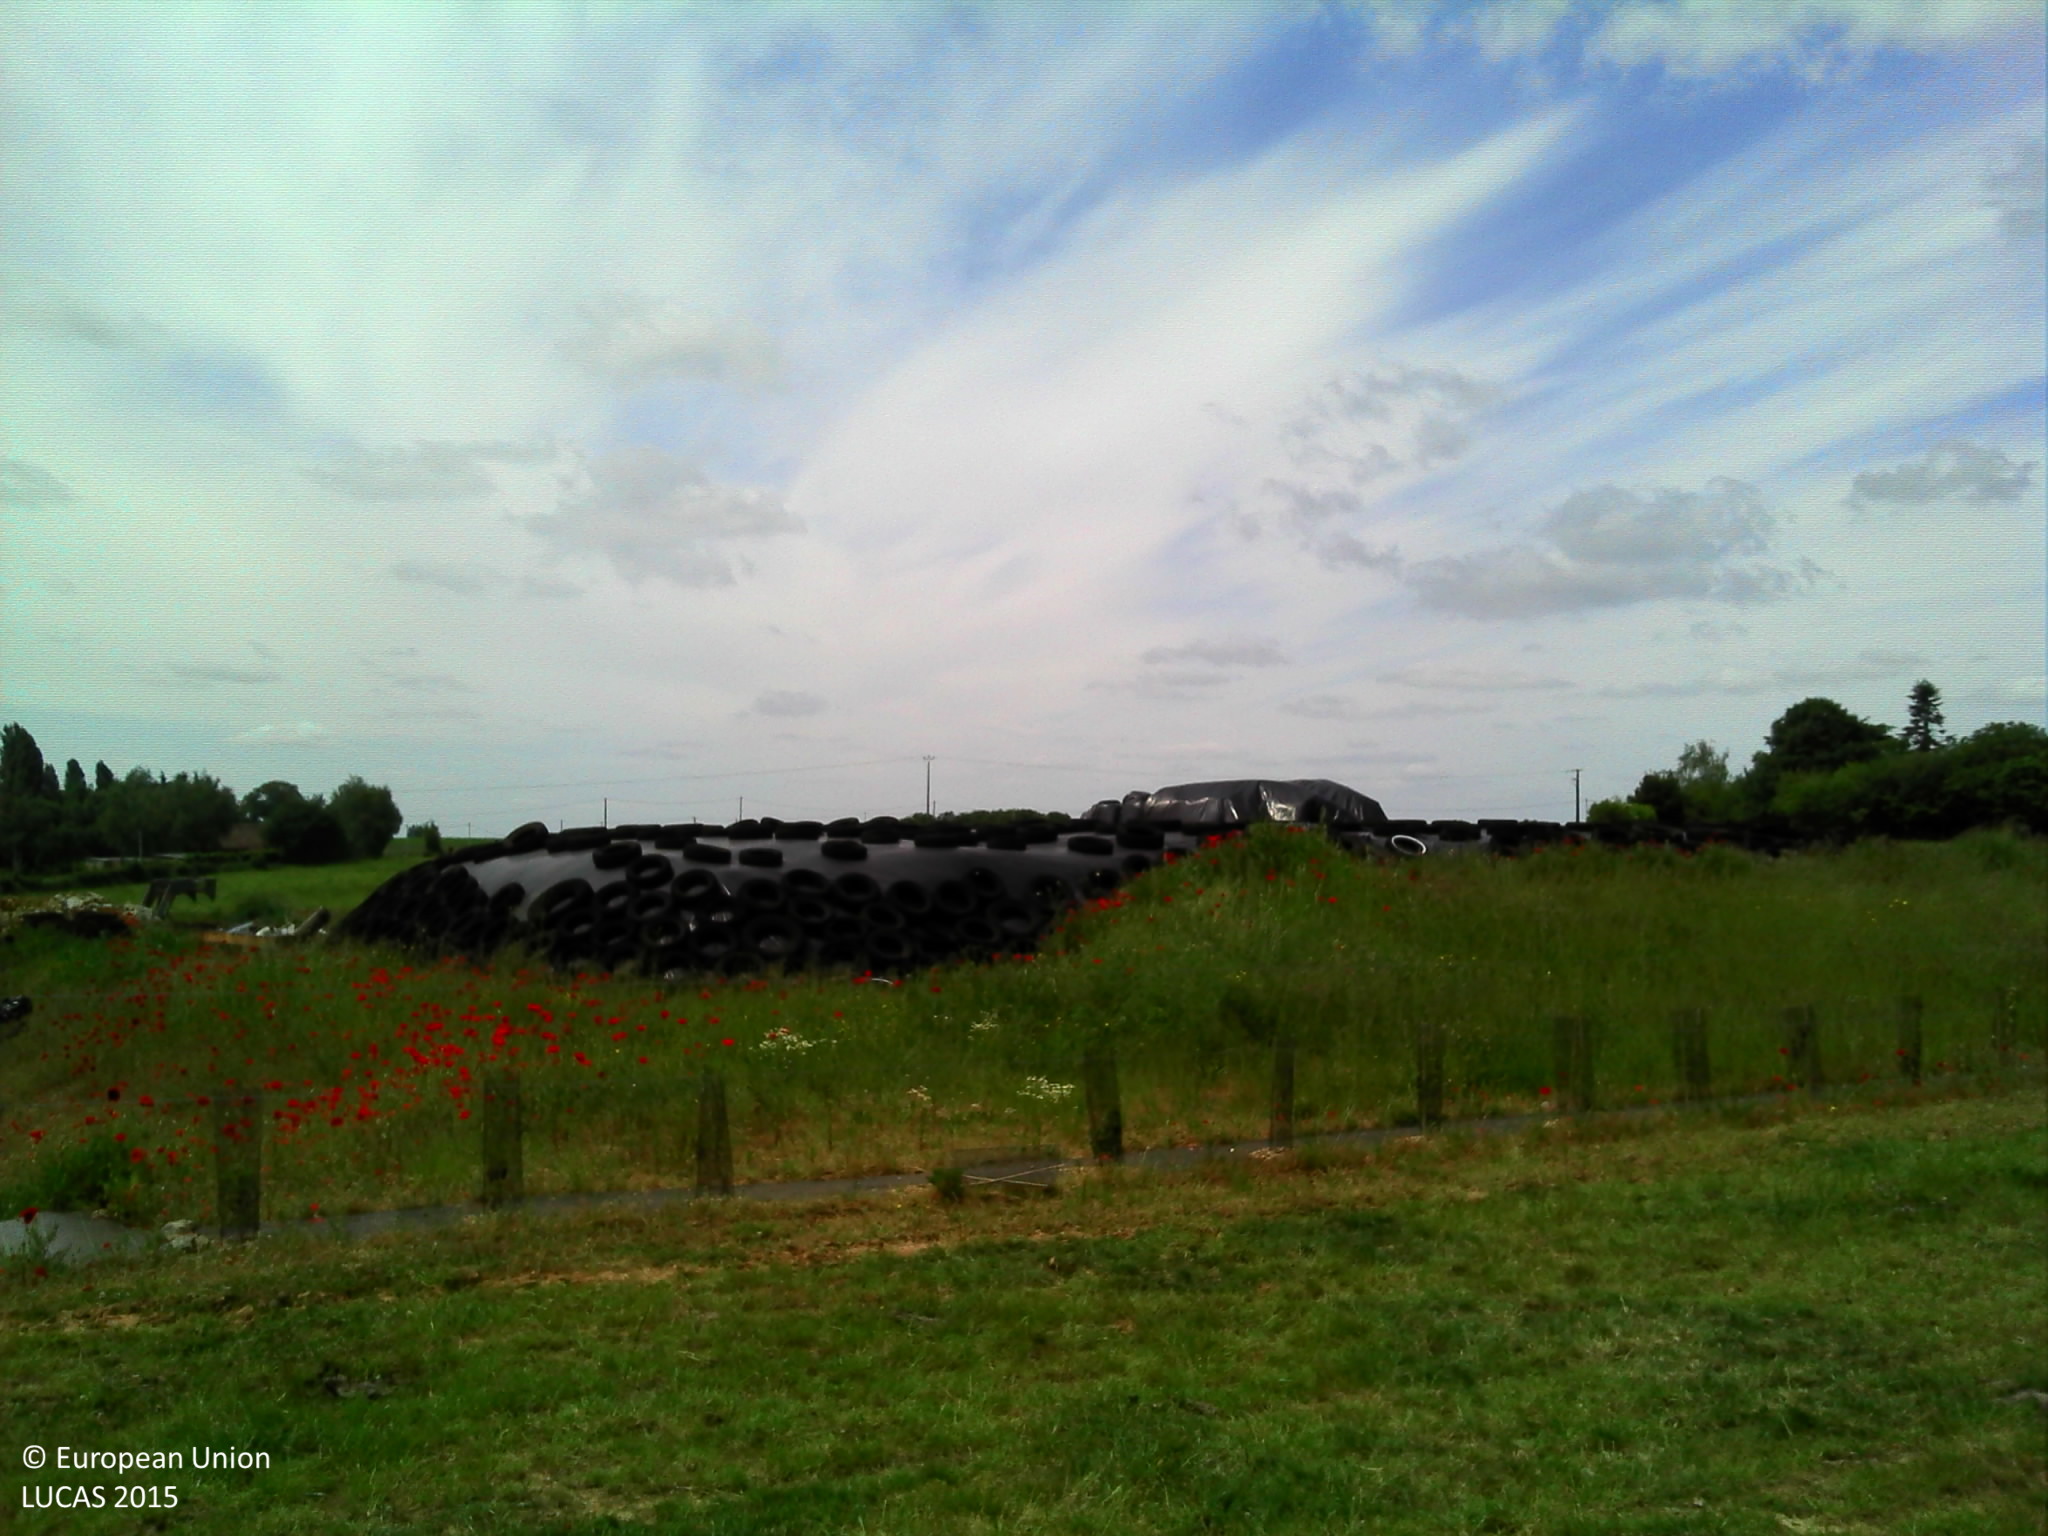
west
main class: Grassland
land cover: Grassland without tree/shrub cover
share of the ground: > 75 %
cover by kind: herbaceous plants 100 %
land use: Agriculture (excluding fallow land and kitchen gardens)
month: May
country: FR
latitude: 47.9868
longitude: 0.0167
